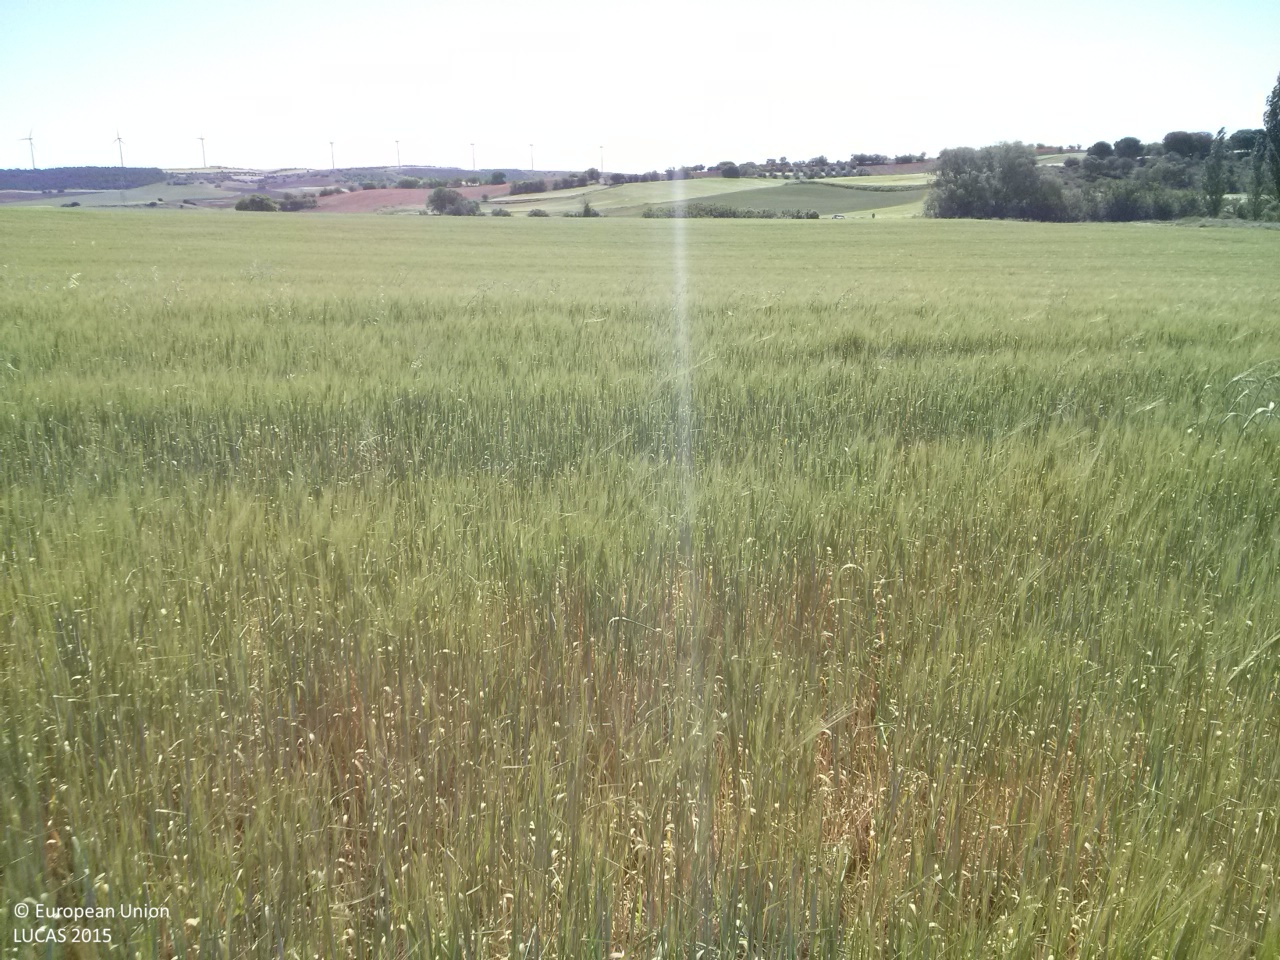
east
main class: Cropland
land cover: Barley
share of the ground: > 75 %
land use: Agriculture (excluding fallow land and kitchen gardens)
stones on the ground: < 10 %
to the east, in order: Barley; Common wheat; Grass margins; Paved roads, cycling and walking lanes; Grass margins; Barley
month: May
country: ES
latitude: 39.9924
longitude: -2.7991
